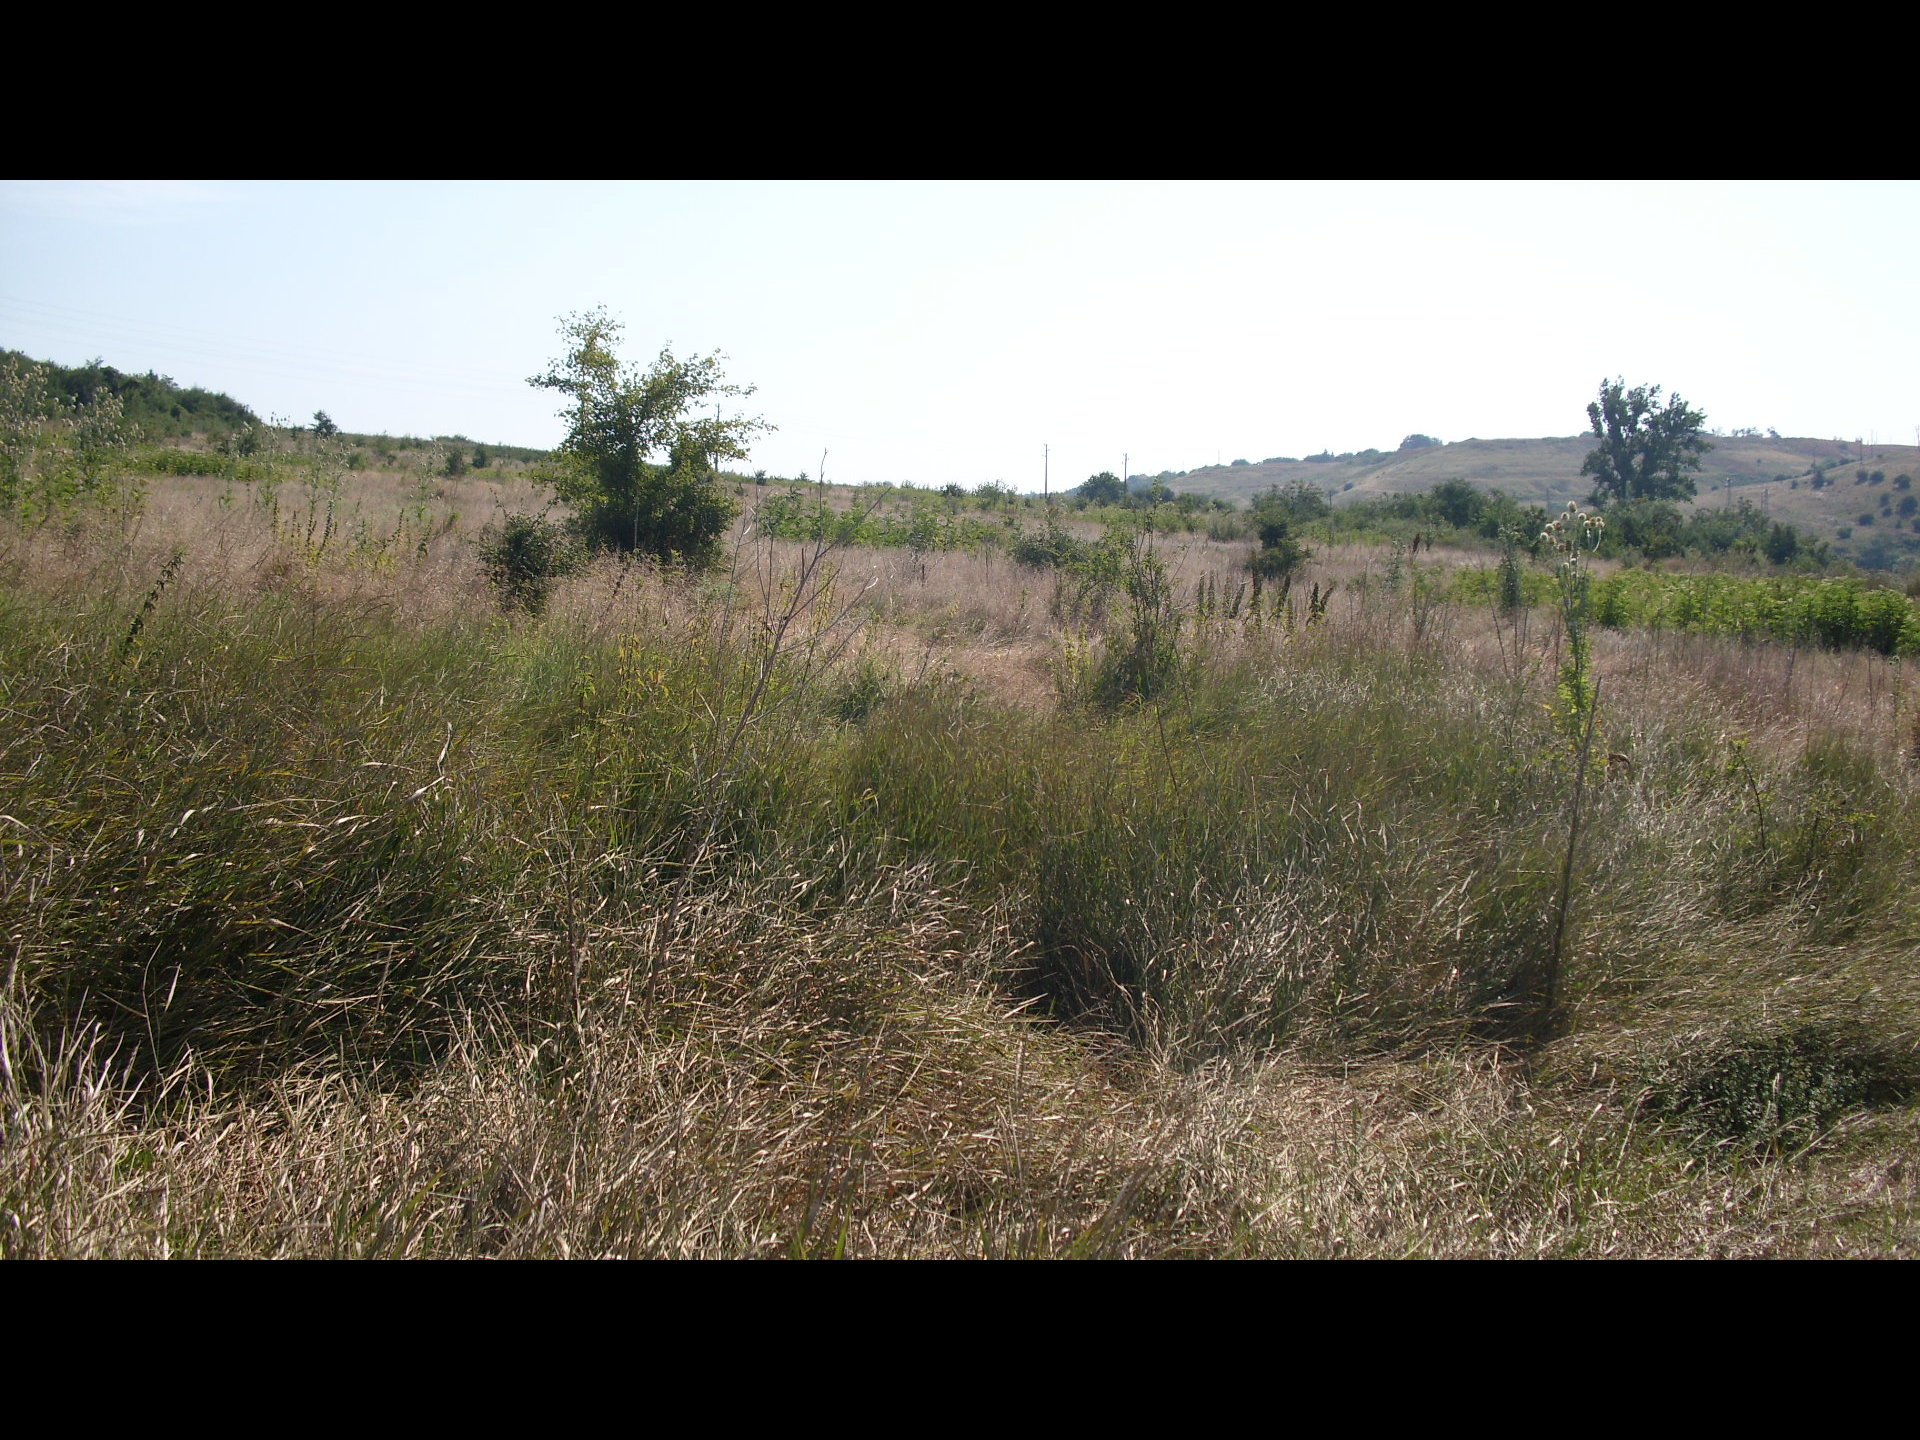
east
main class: Grassland
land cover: Grassland without tree/shrub cover
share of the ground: > 75 %
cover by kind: herbaceous plants 100 %
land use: Agriculture (excluding fallow land and kitchen gardens)
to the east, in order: Grassland without tree/shrub cover; Shrubland with sparse tree cover; Broadleaved woodland; Grassland with sparse tree/shrub cover; Shrubland with sparse tree cover
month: July
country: BG
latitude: 43.8305
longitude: 22.6320
